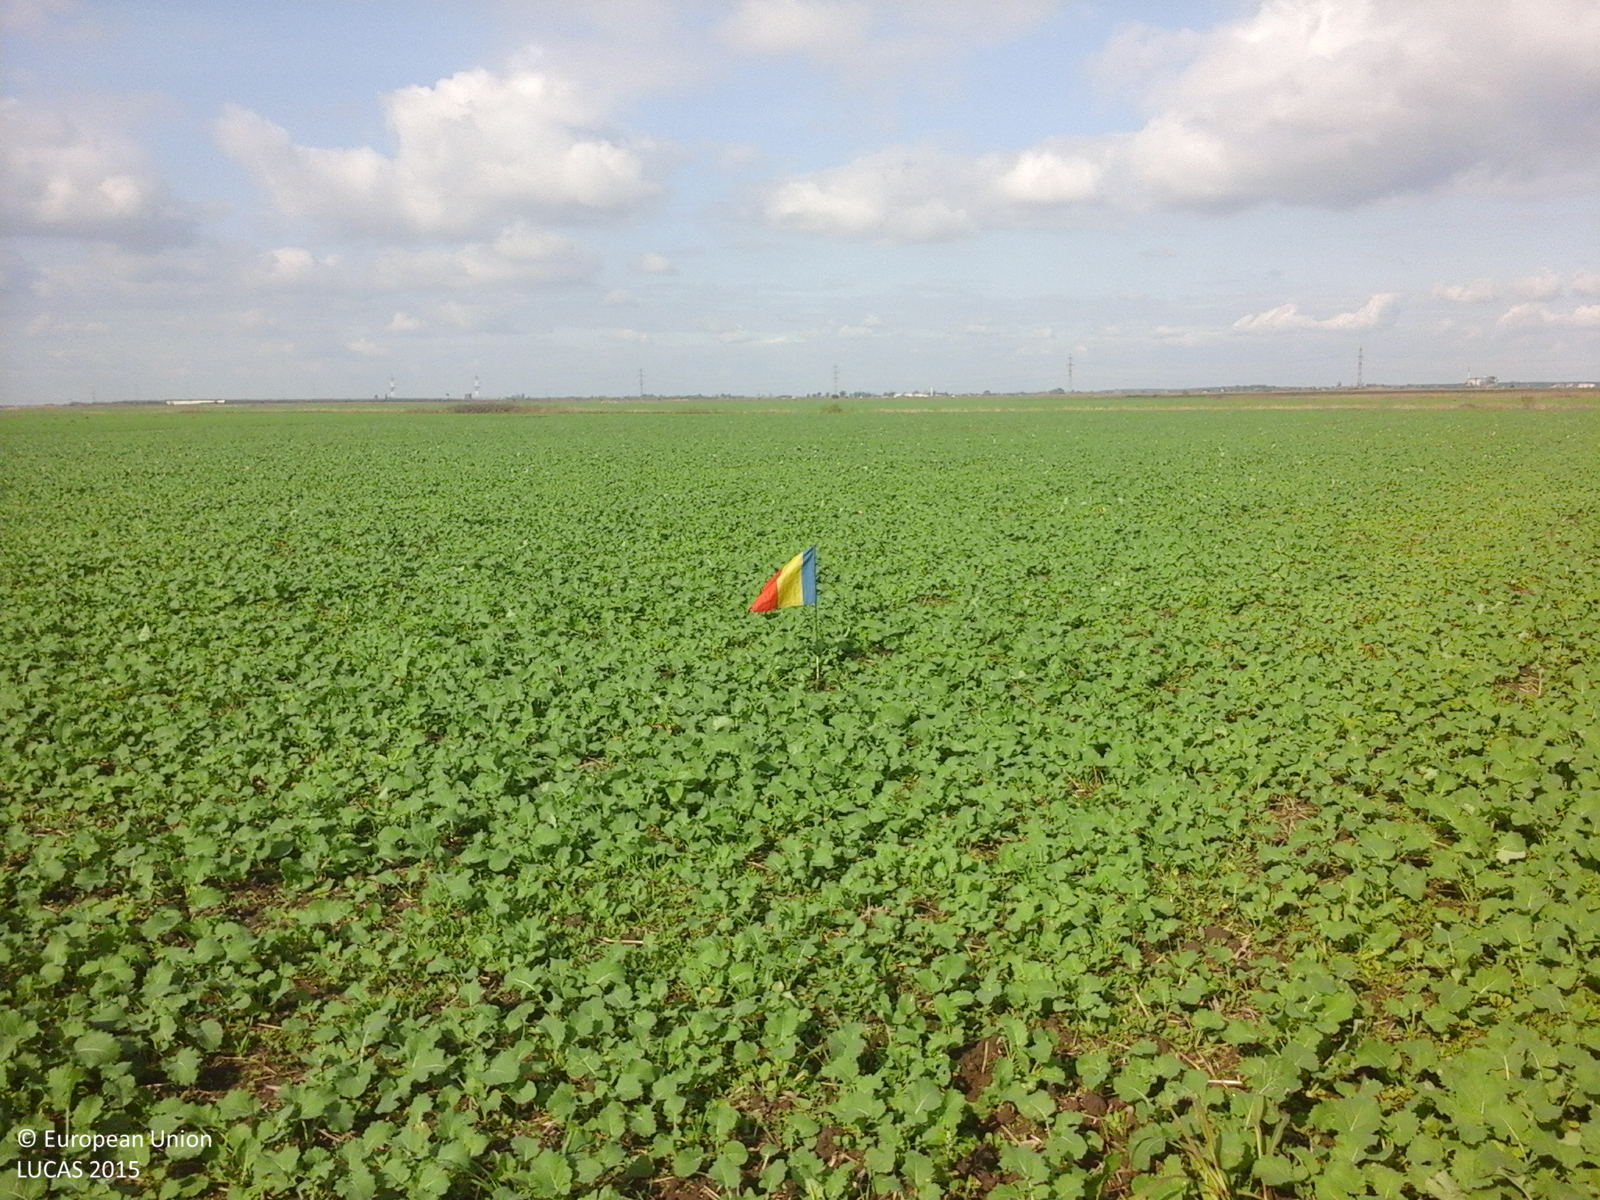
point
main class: Cropland
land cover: Rape and turnip rape
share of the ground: > 75 %
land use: Agriculture (excluding fallow land and kitchen gardens)
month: October
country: RO
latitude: 44.6409
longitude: 26.0027
